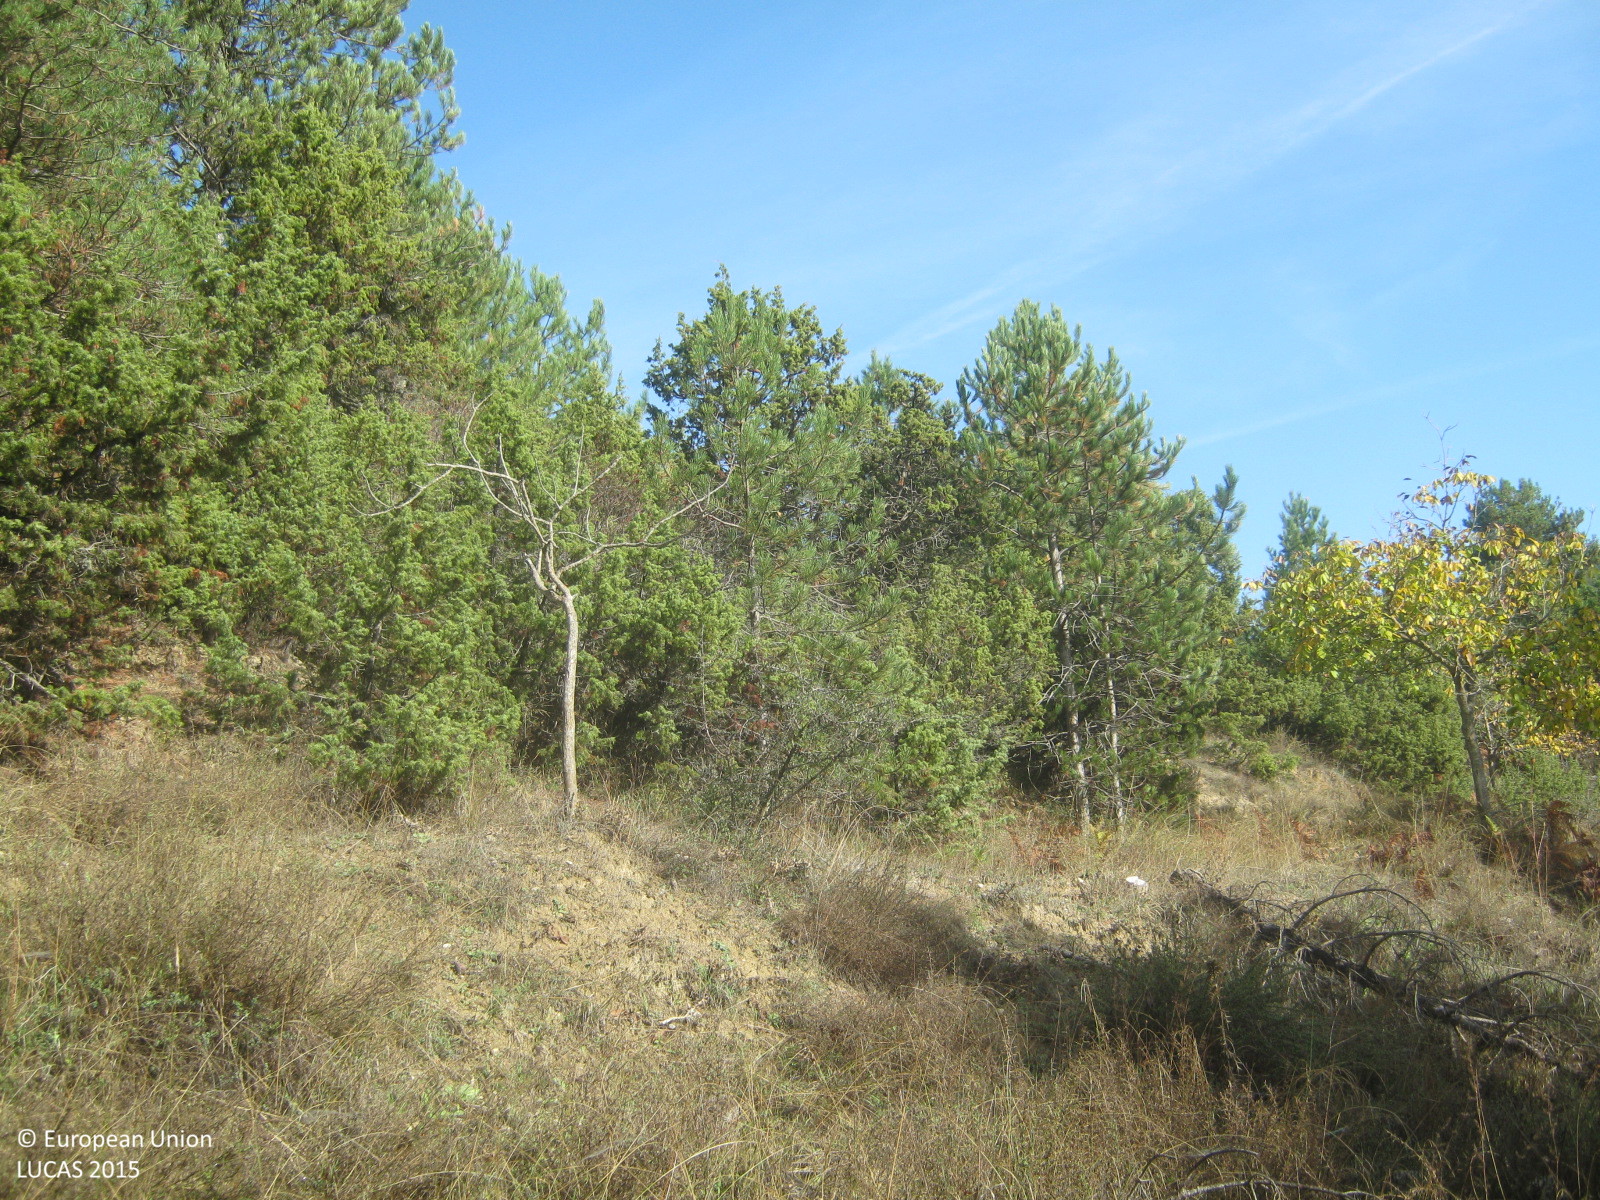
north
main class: Woodland
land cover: Pine dominated mixed woodland
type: coniferous forest of the mediterranean region
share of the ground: > 75 %
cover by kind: coniferous forest trees 60 %, broadleaved forest trees 25 %, herbaceous plants 15 %
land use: Forestry
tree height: > 5 m
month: October
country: GR
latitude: 38.0112
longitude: 22.4180
